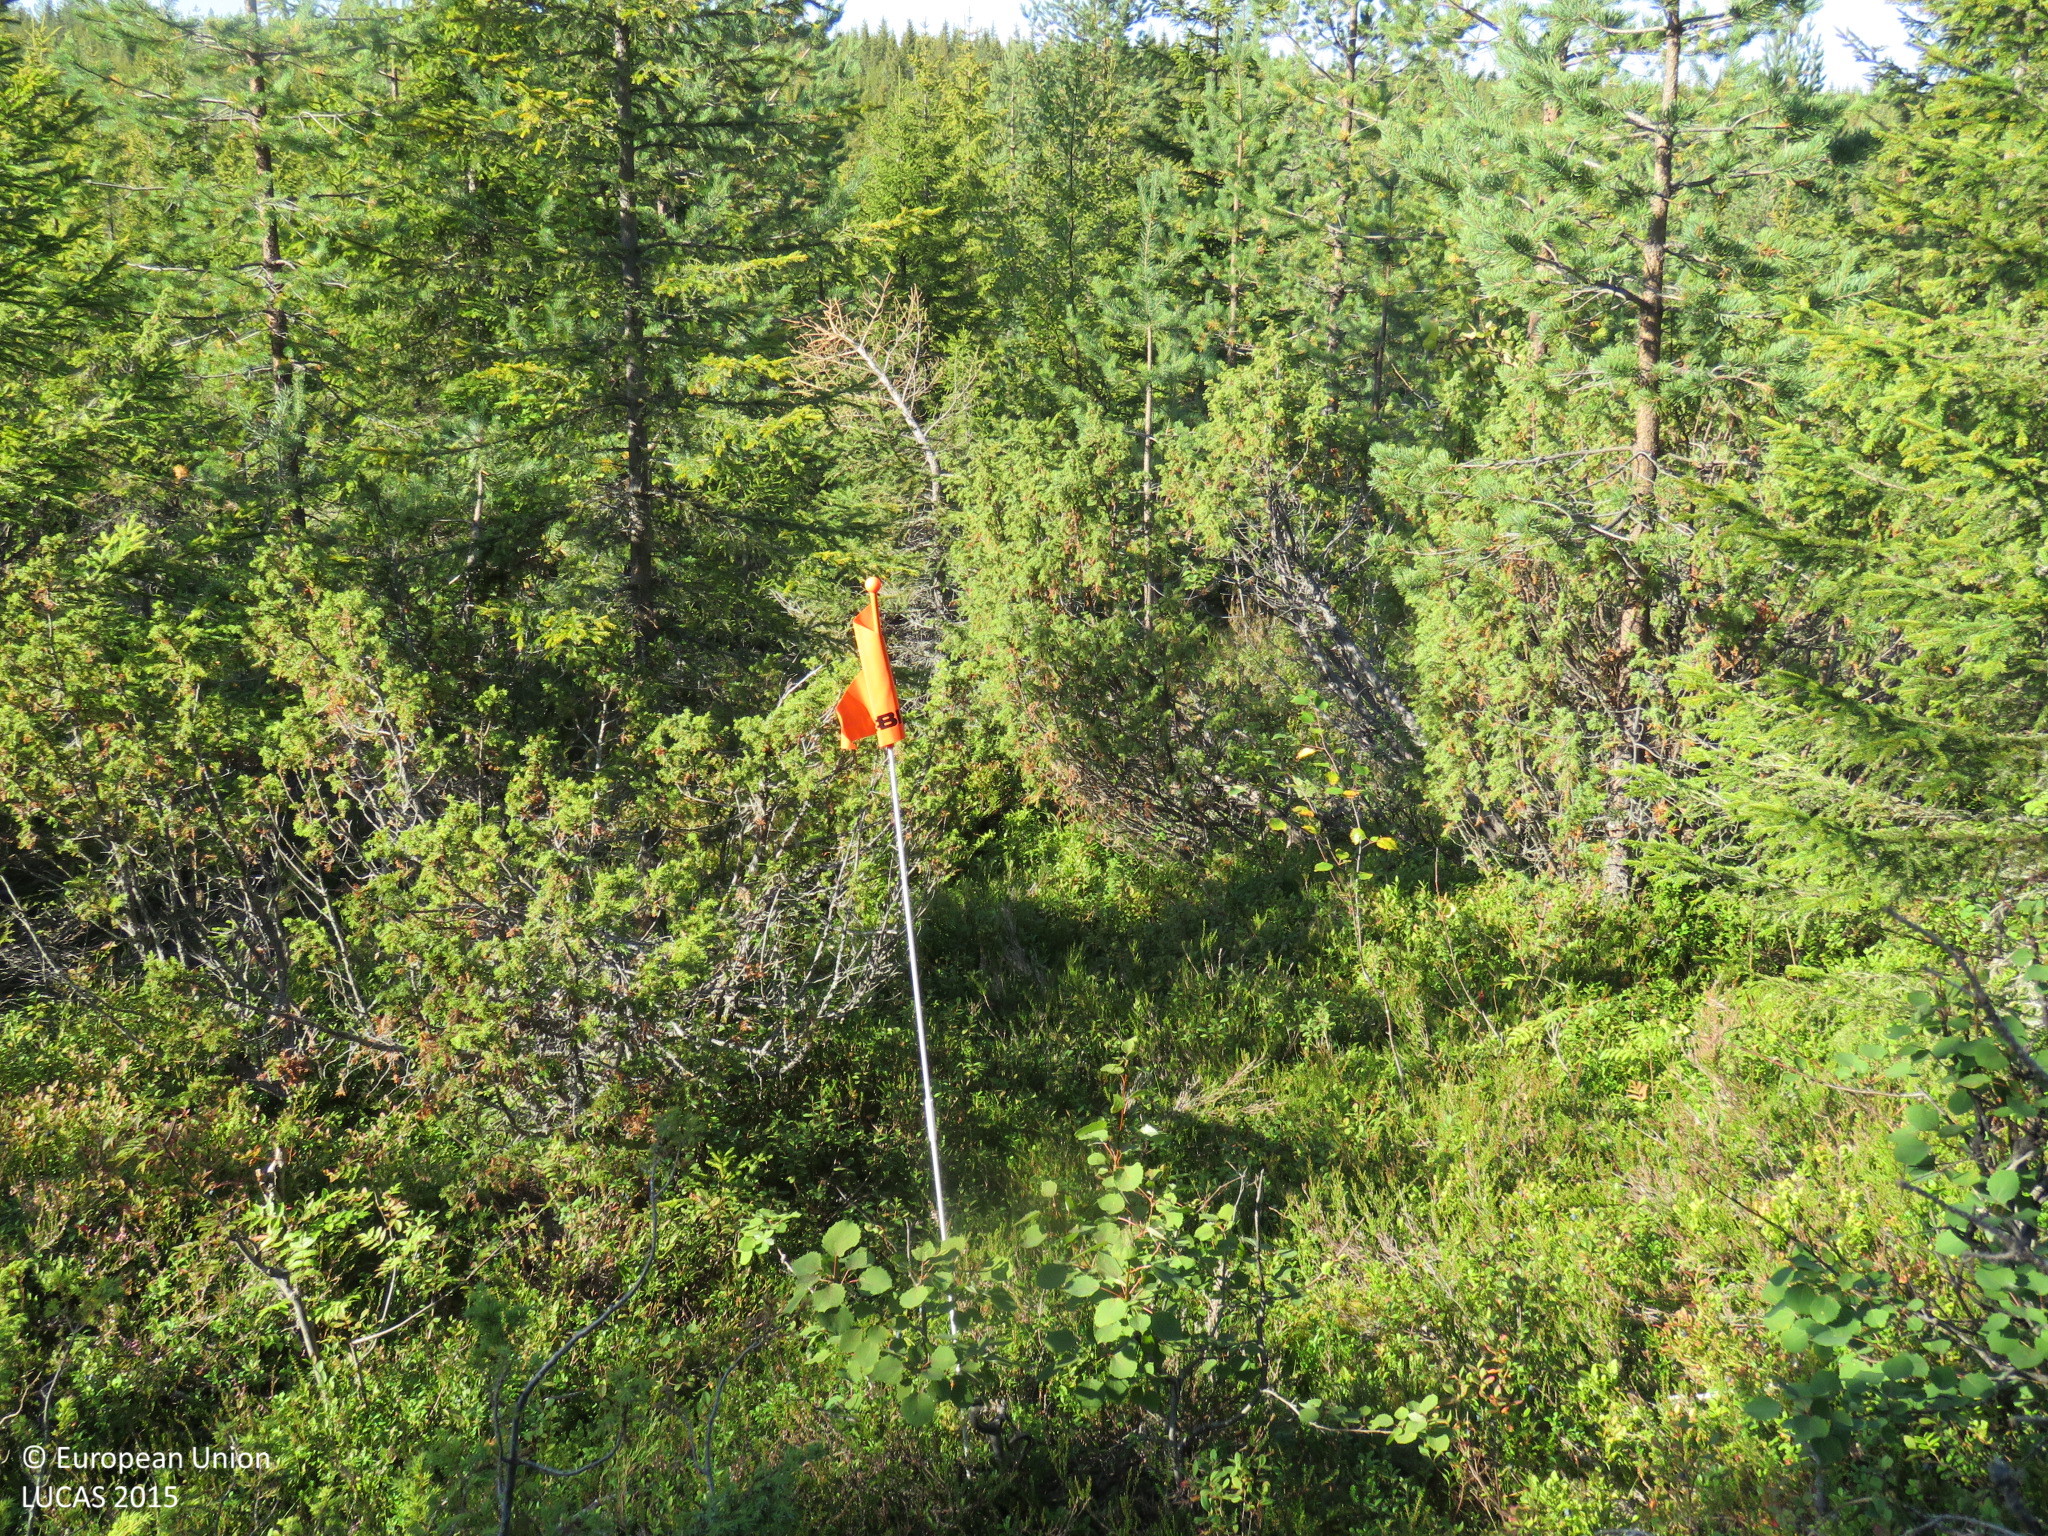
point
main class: Woodland
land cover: Spruce dominated coniferous woodland
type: boreal forest
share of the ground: > 75 %
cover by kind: coniferous forest trees 70 %, shrubs 25 %, broadleaved forest trees 5 %
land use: Forestry
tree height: > 5 m
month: September
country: FI
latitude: 65.5486
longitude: 27.5598
